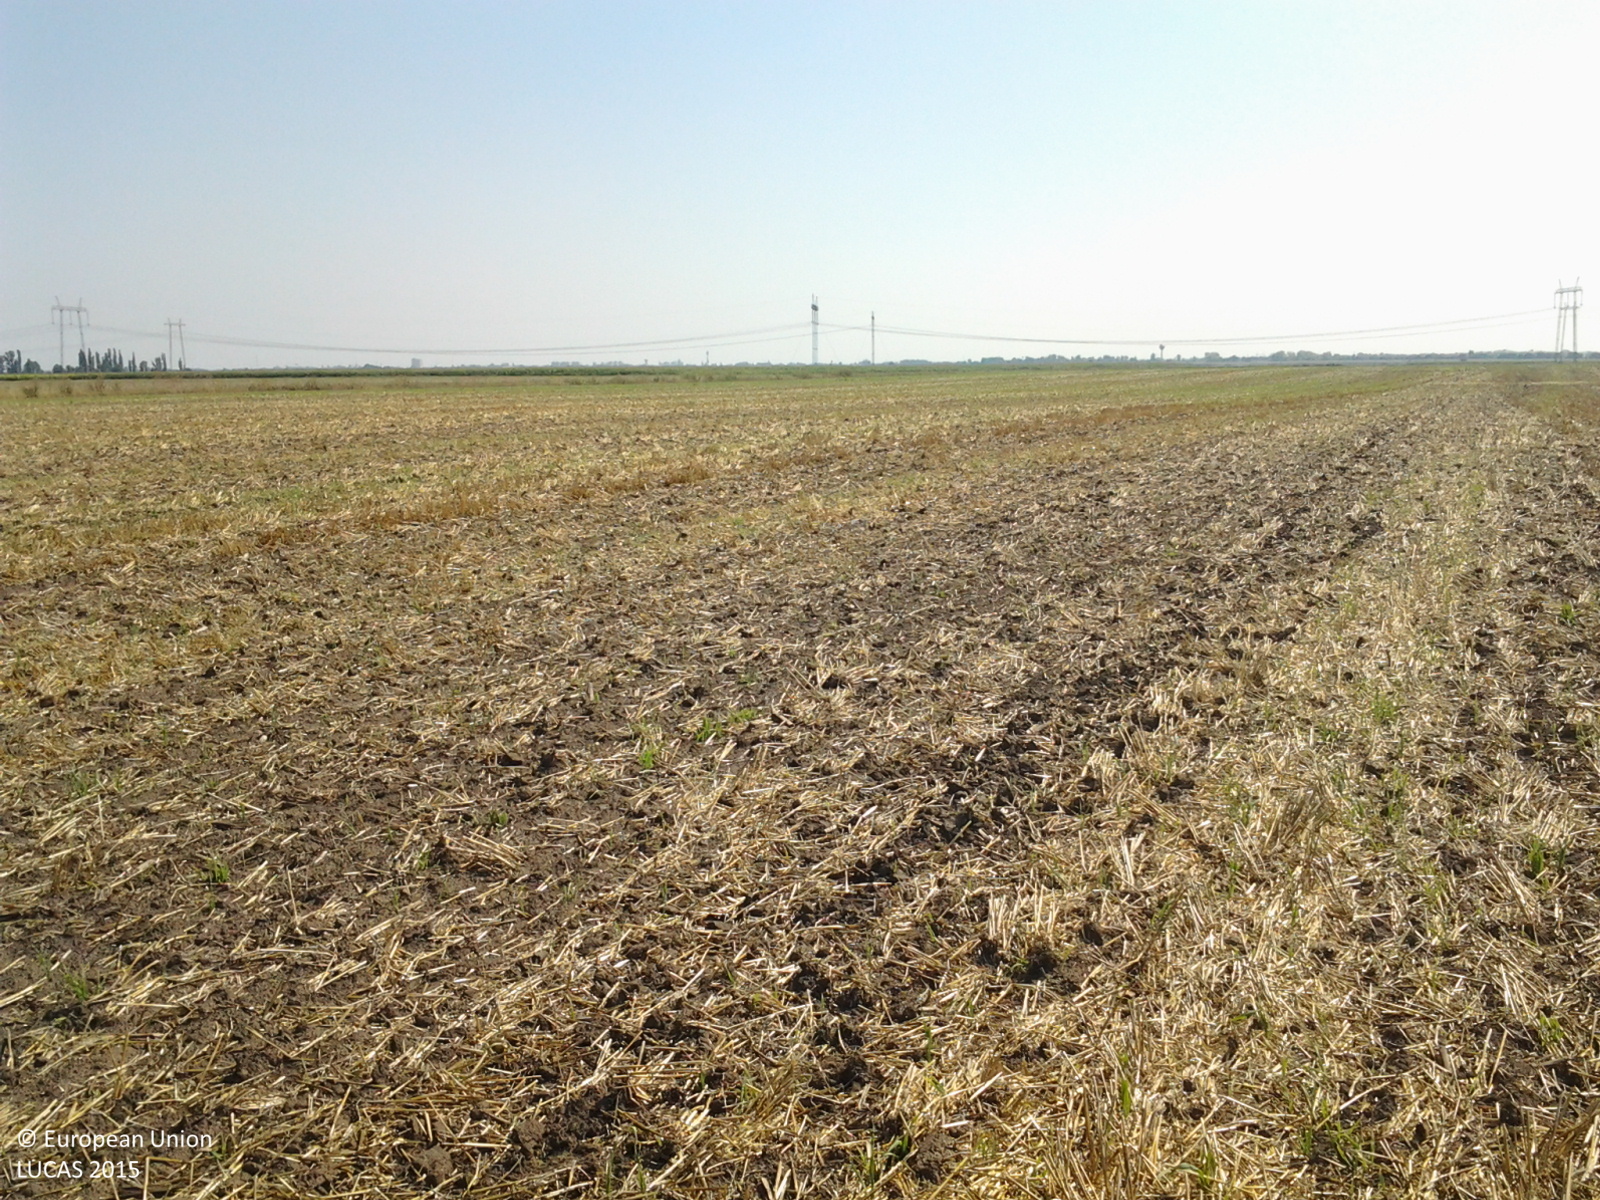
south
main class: Cropland
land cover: Barley
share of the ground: 10 - 25 %
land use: Agriculture (excluding fallow land and kitchen gardens)
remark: Harvested field
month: August
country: HU
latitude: 47.2434
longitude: 19.7860
